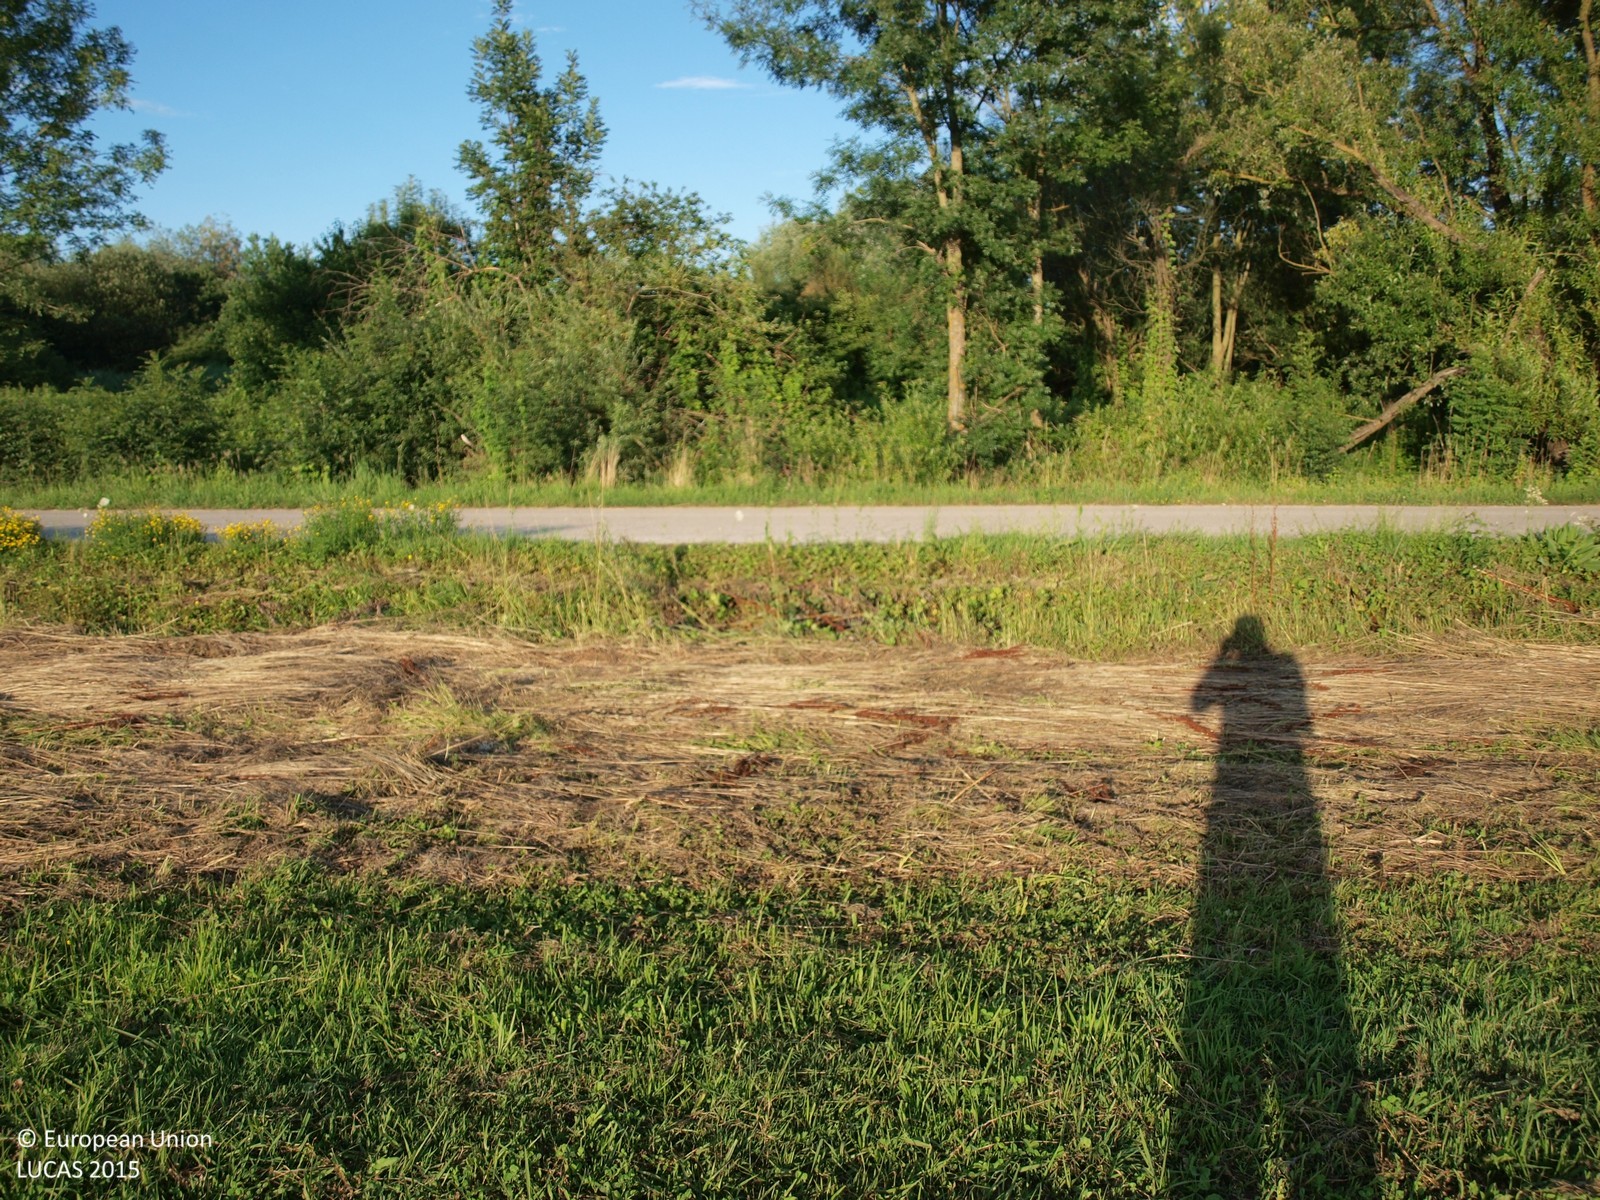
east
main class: Grassland
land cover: Grassland without tree/shrub cover
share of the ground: > 75 %
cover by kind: herbaceous plants 100 %
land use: Agriculture (excluding fallow land and kitchen gardens)
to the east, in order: Grassland without tree/shrub cover; Paved roads, cycling and walking lanes; Shrubland with sparse tree cover; Tracks; Maize
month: June
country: HR
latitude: 46.2523
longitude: 16.6553
